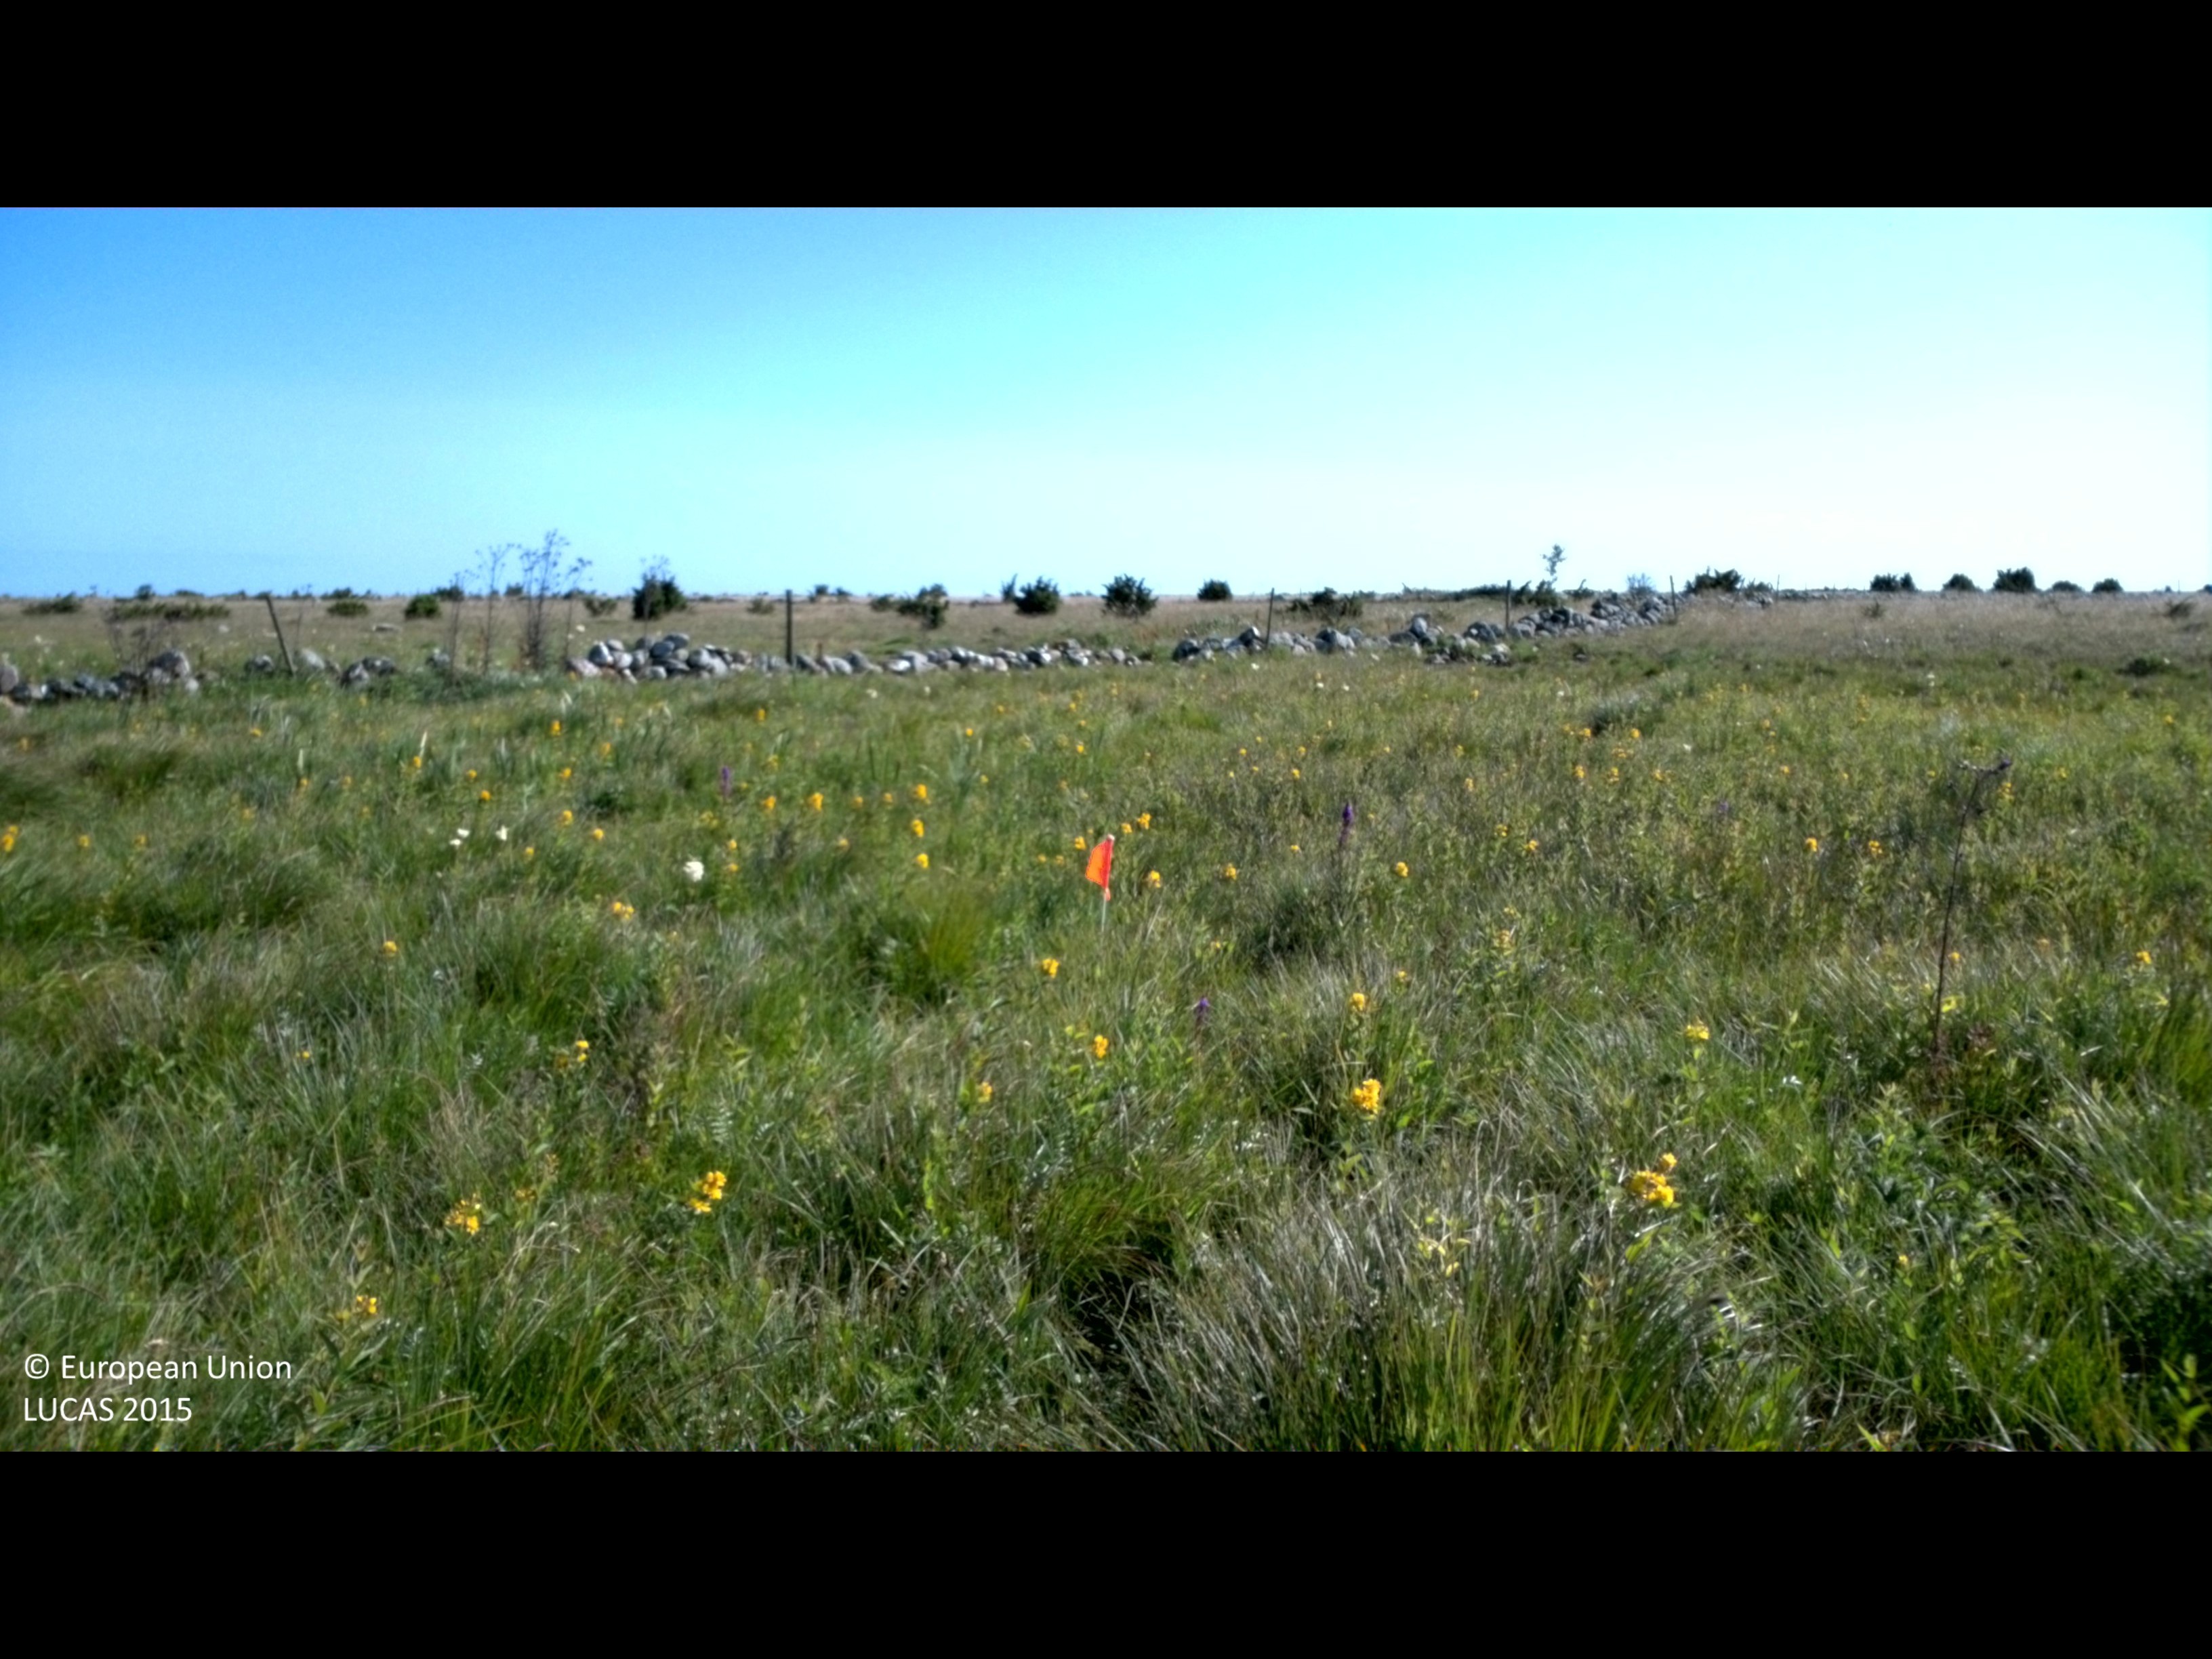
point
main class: Grassland
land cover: Grassland without tree/shrub cover
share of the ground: > 75 %
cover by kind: herbaceous plants 100 %
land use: Agriculture (excluding fallow land and kitchen gardens)
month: July
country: SE
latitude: 56.9235
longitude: 16.8859
